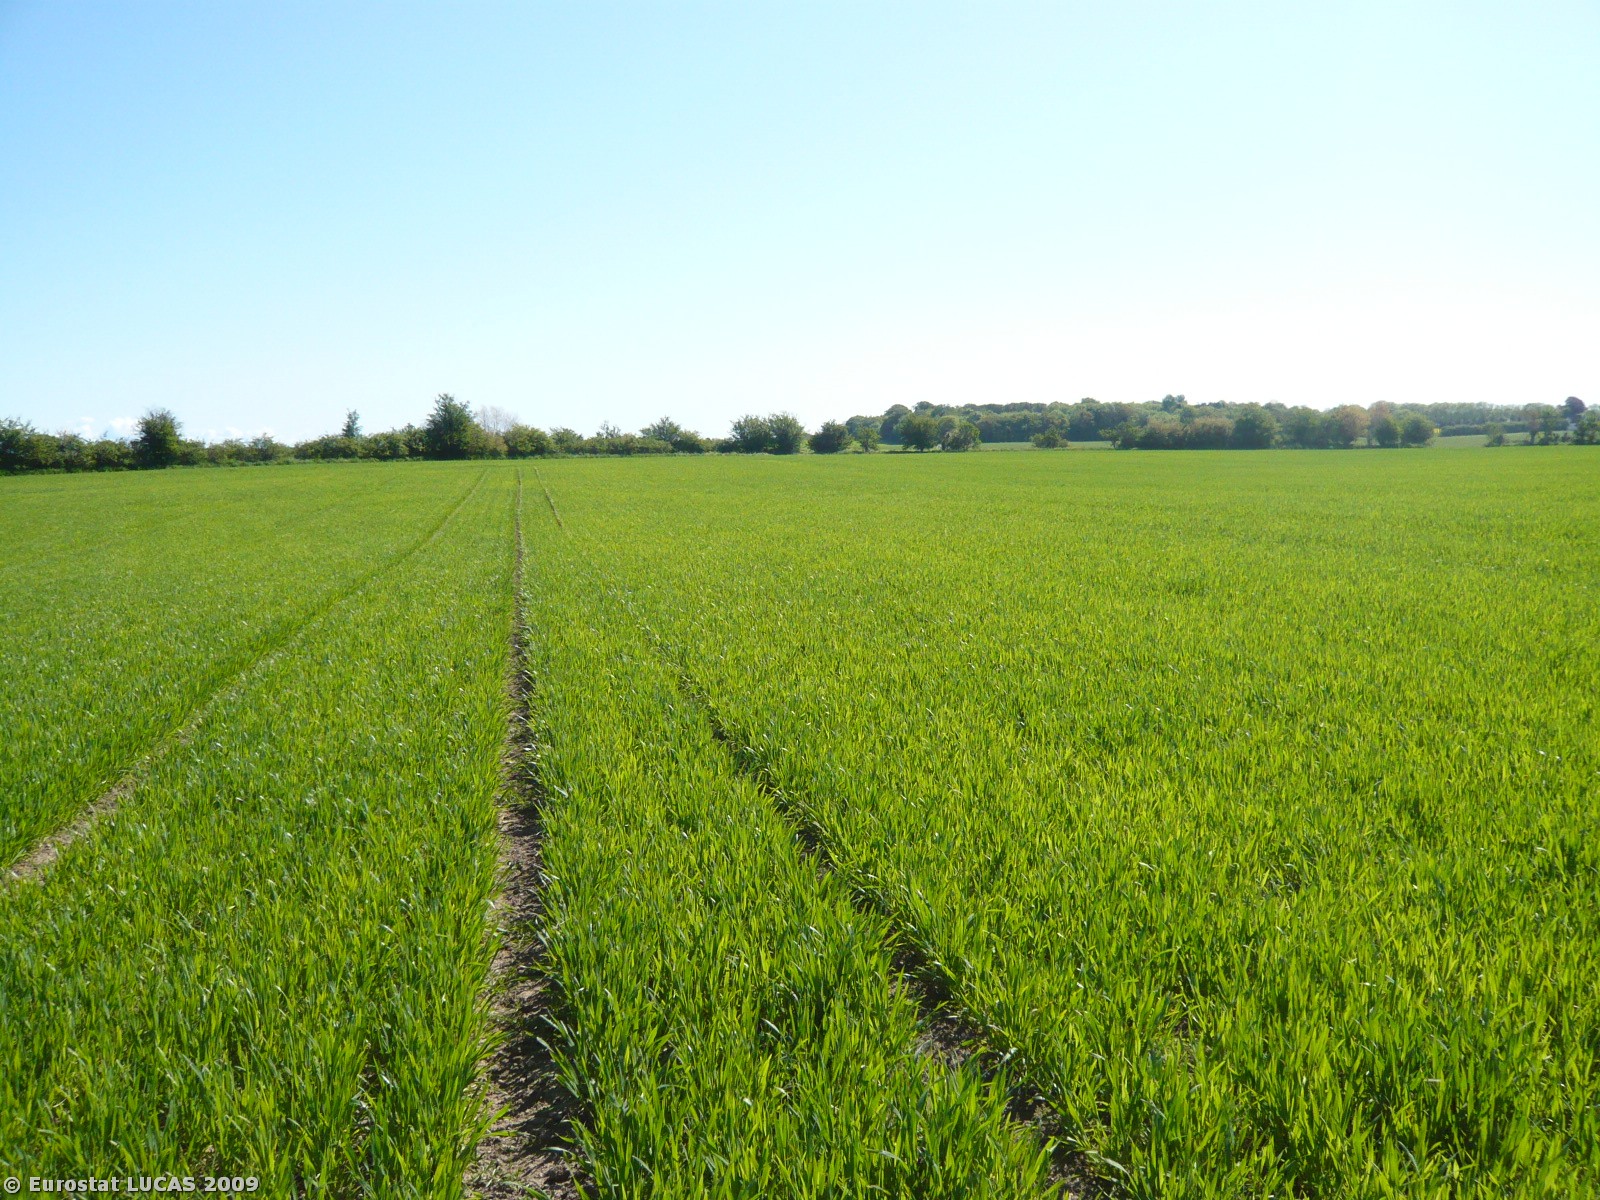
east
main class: Cropland
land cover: Common wheat
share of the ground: > 75 %
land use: Agriculture (excluding fallow land and kitchen gardens)
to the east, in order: Common wheat; Dry stone walls; Broadleaved woodland; Grassland without tree/shrub cover; Common wheat
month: May
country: DK
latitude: 55.0746
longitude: 12.0503
